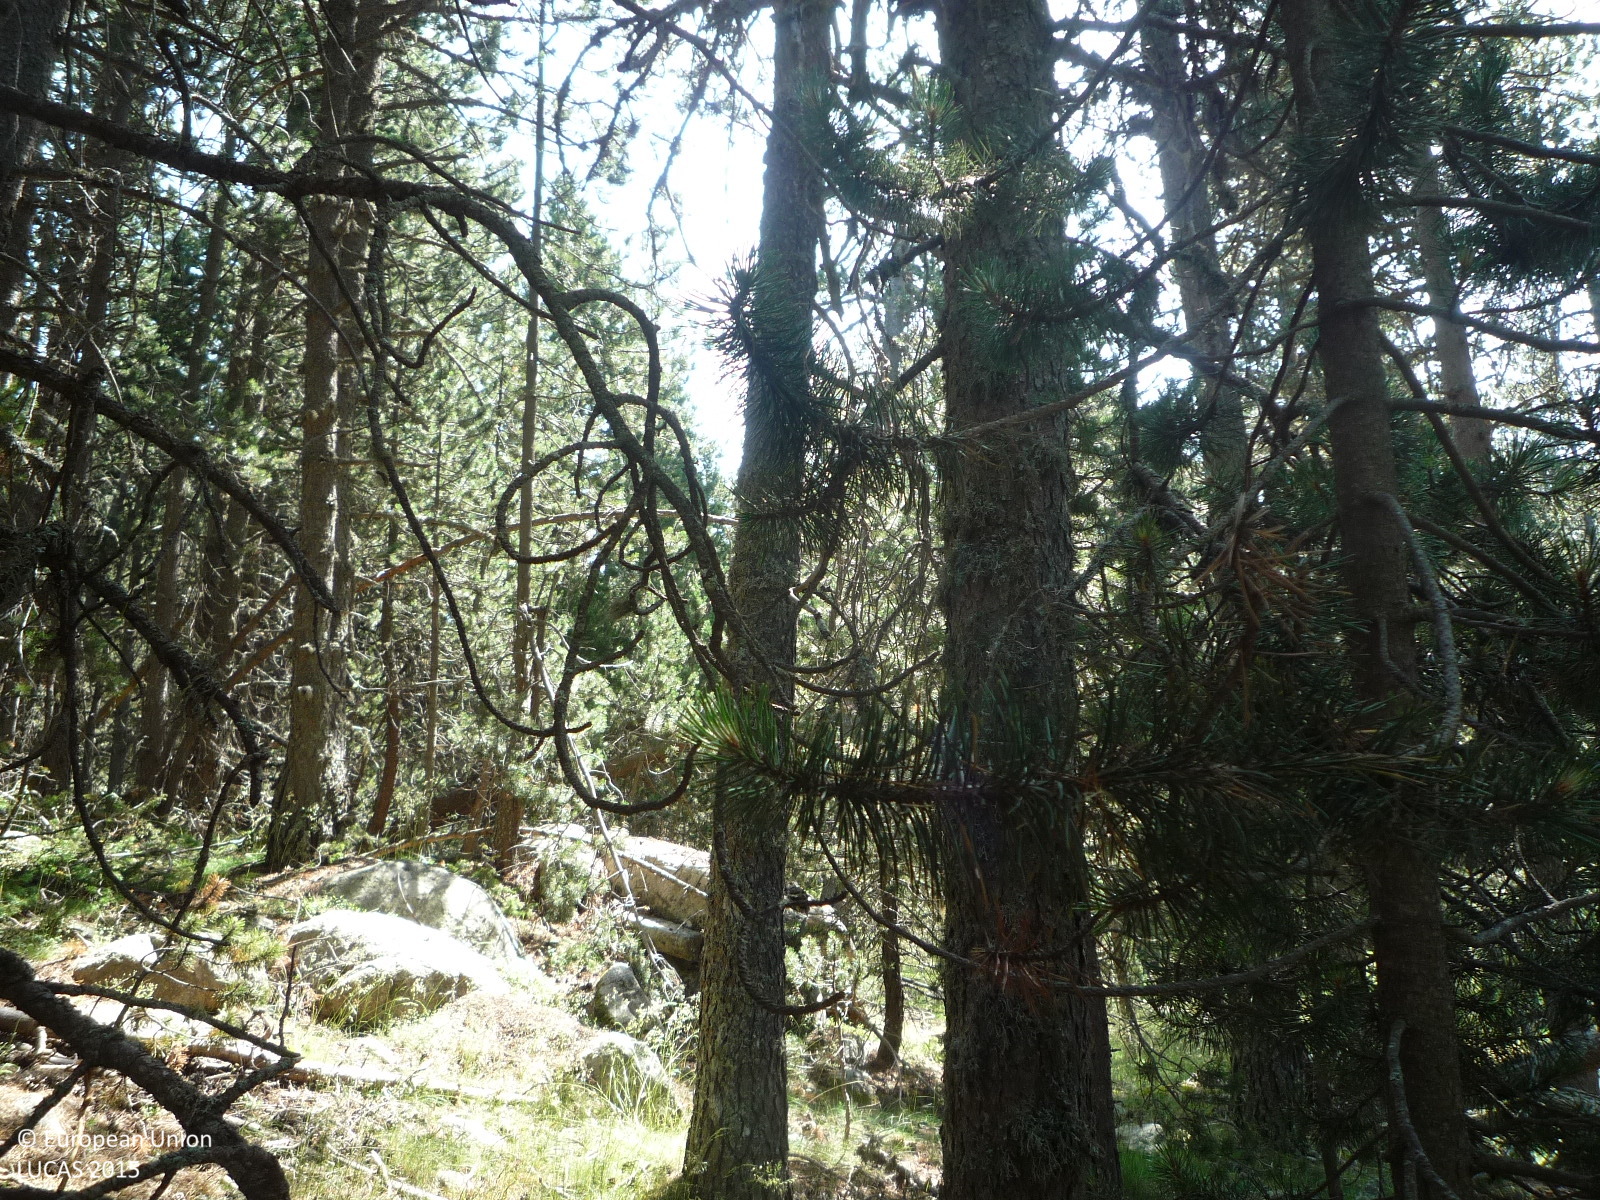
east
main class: Woodland
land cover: Pine dominated coniferous woodland
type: alpine coniferous forest
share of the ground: > 75 %
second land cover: Grassland without tree/shrub cover
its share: 25 - 50 %
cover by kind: coniferous forest trees 90 %, herbaceous plants 10 %
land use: Forestry
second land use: Agriculture (excluding fallow land and kitchen gardens)
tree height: > 5 m
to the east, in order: Pine dominated coniferous woodland; Grassland without tree/shrub cover; Rivers and streams; Pine dominated coniferous woodland; Grassland with sparse tree/shrub cover; Tracks; Pine dominated coniferous woodland; Rock outcrops; Pine dominated coniferous woodland; Tracks; Grassland without tree/shrub cover; Tracks; Pine dominated coniferous woodland
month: July
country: ES
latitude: 42.4365
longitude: 1.6589
